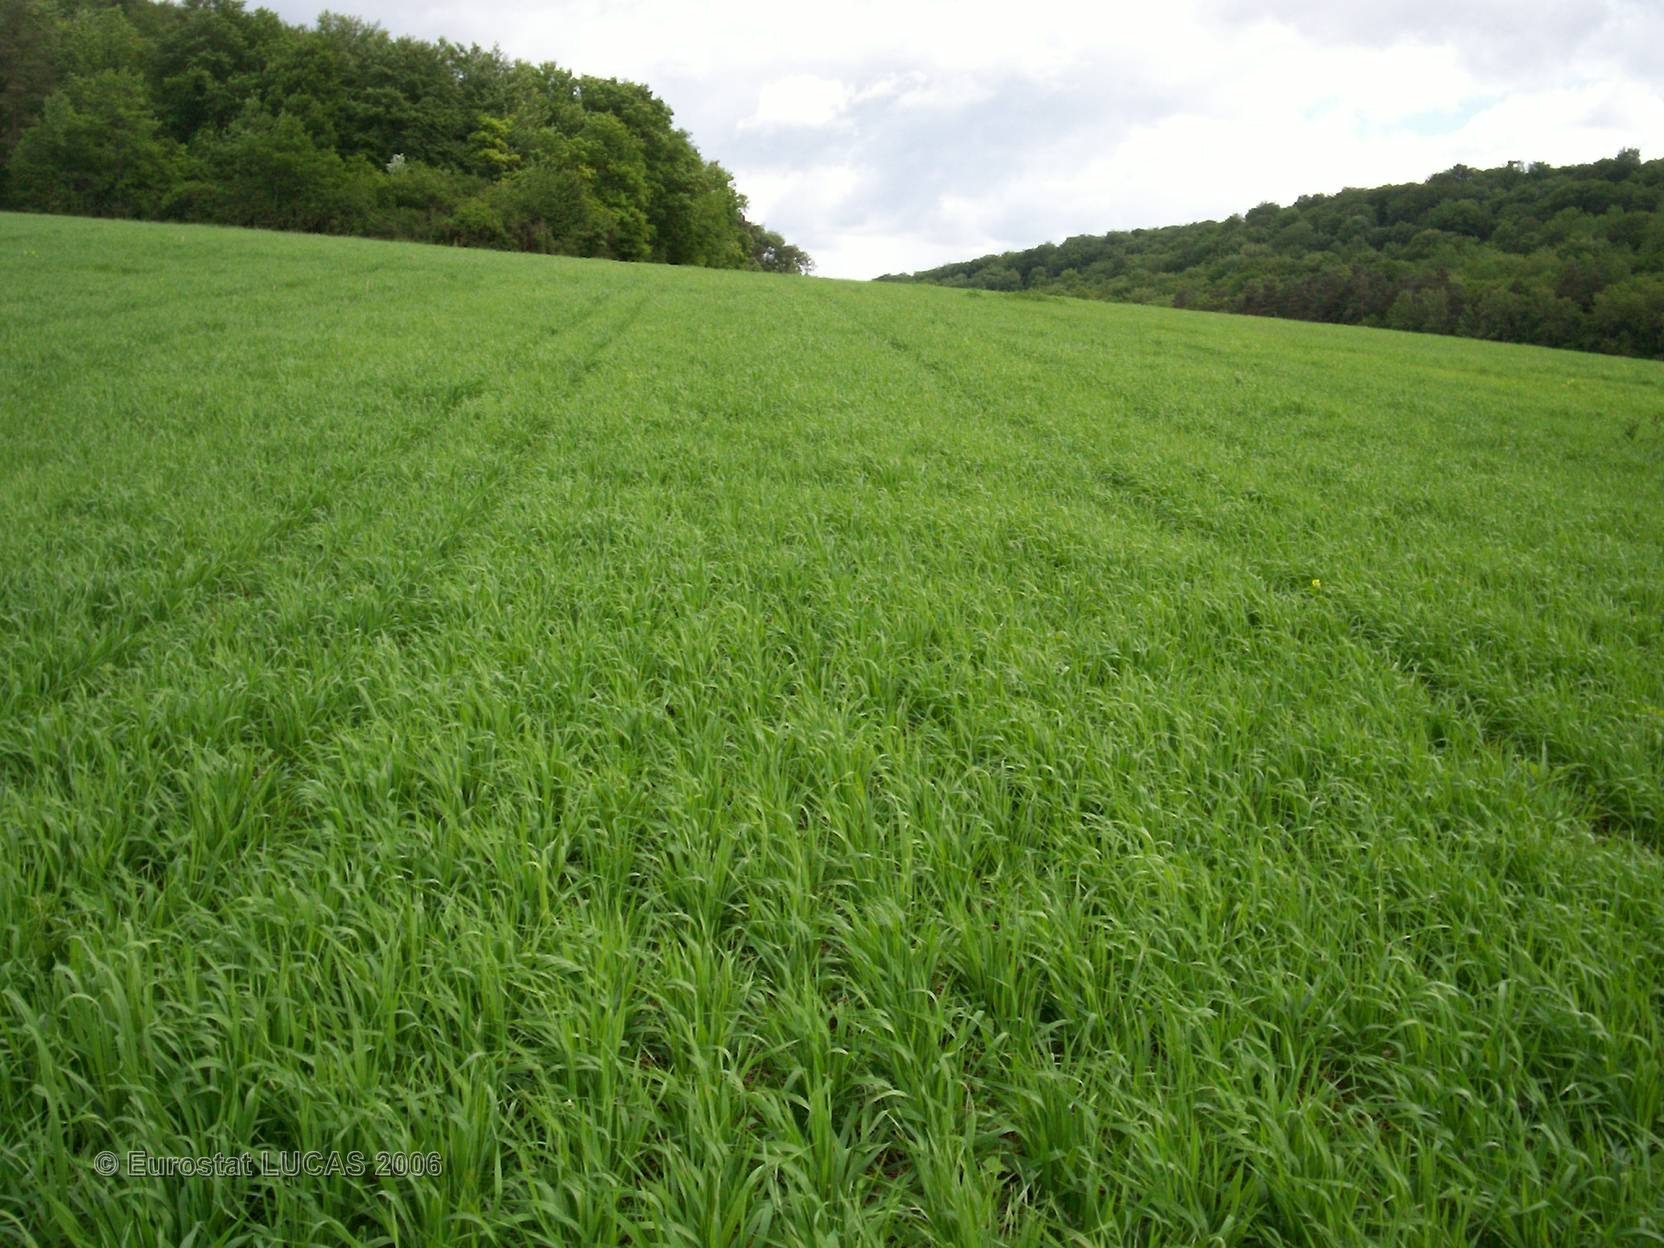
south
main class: Cropland
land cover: Barley
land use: Agriculture (excluding fallow land and kitchen gardens)
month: May
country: FR
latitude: 48.2035
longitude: 4.6832
